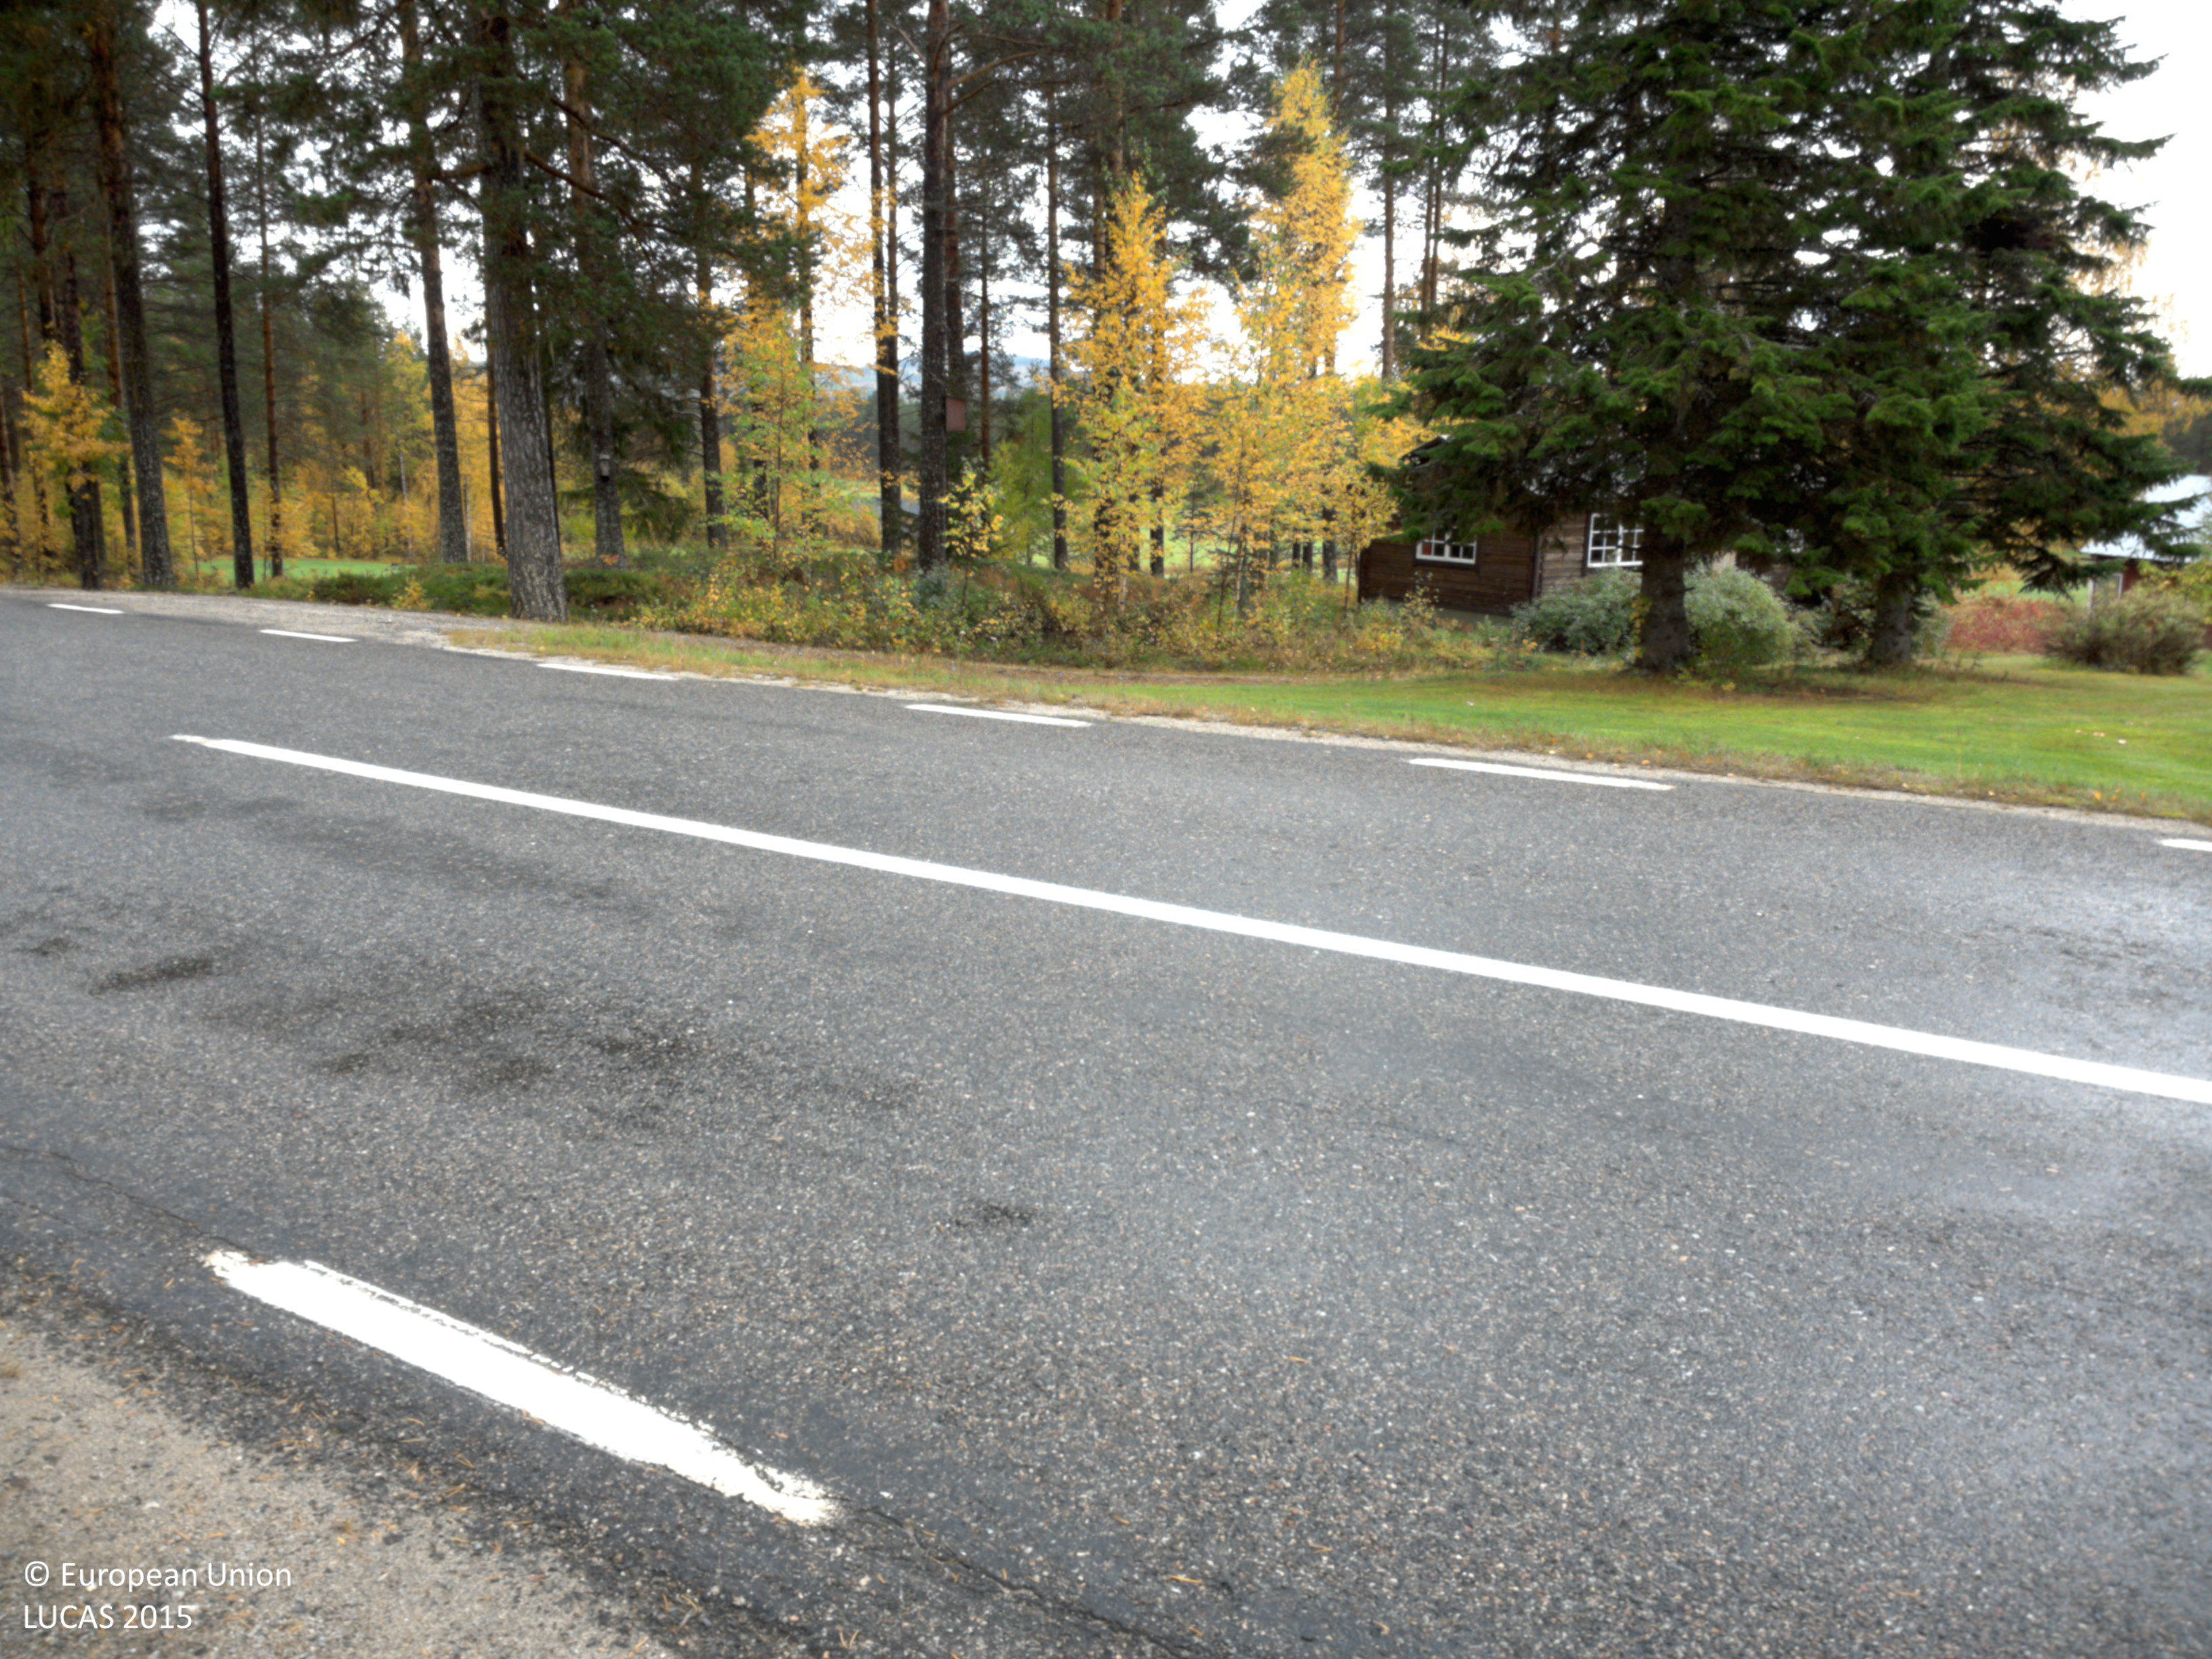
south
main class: Woodland
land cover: Pine dominated mixed woodland
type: boreal forest
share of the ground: > 75 %
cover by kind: coniferous forest trees 55 %, broadleaved forest trees 25 %, shrubs 10 %, herbaceous plants 5 %, lichens and mosses 5 %
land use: Forestry
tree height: > 5 m
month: September
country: SE
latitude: 64.7168
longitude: 19.1387
